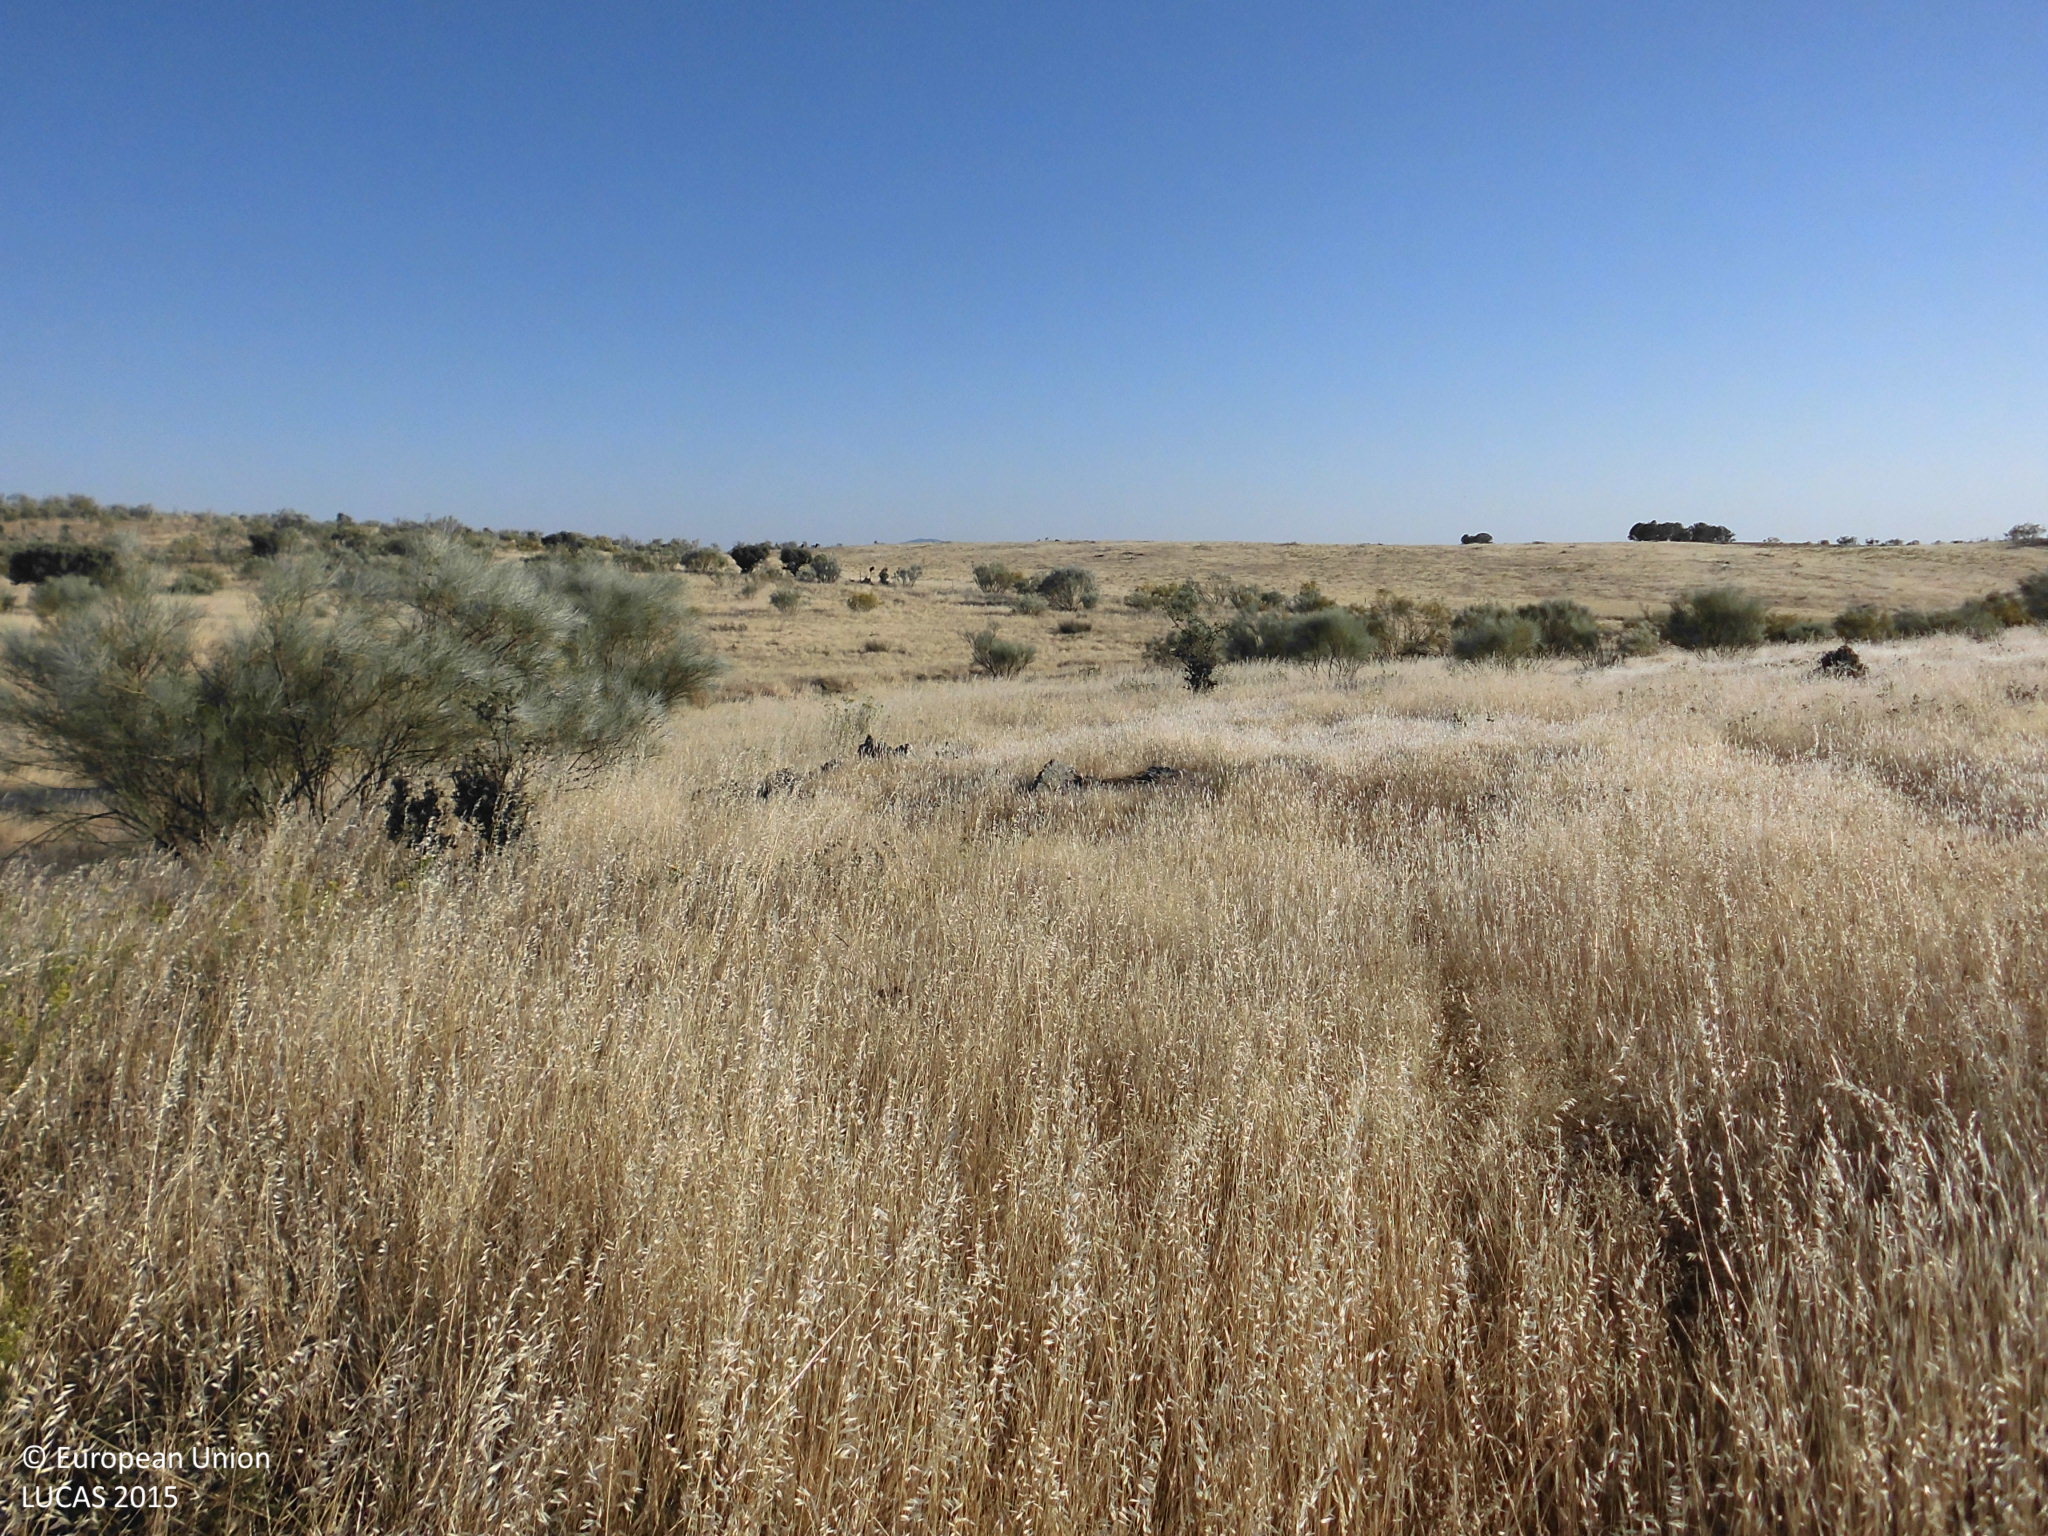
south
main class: Shrubland
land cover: Shrubland without tree cover
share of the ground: 10 - 25 %
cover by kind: herbaceous plants 90 %, shrubs 10 %
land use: Agriculture (excluding fallow land and kitchen gardens)
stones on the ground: 10 - 25 %
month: May
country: ES
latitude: 39.5391
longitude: -5.9668
